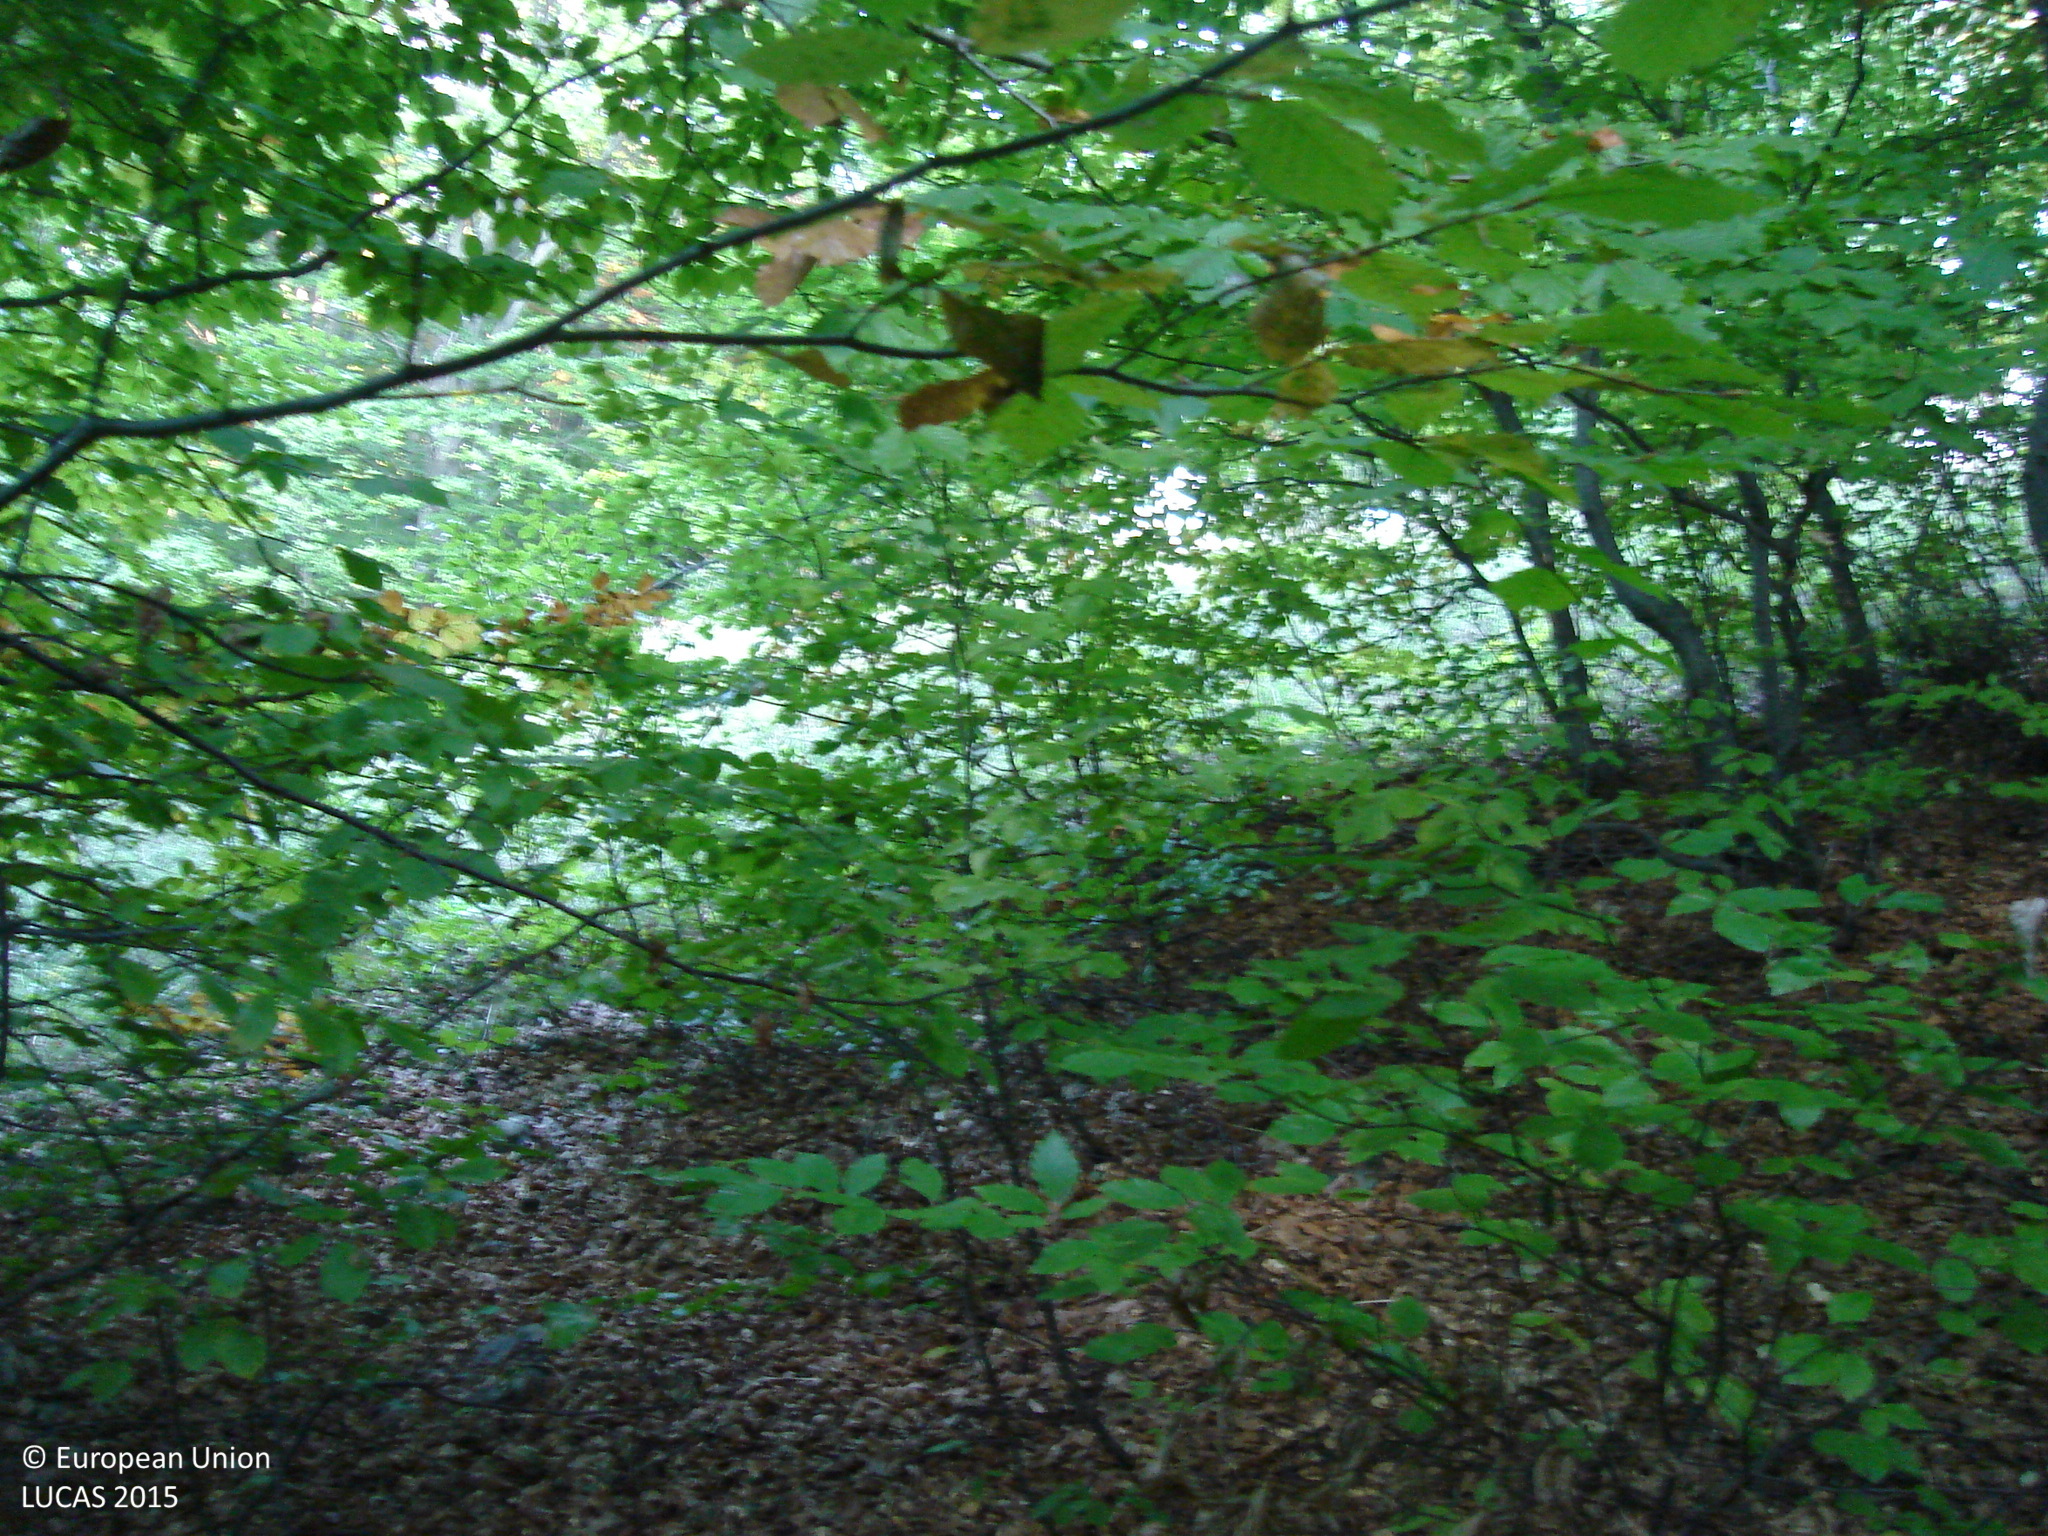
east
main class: Woodland
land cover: Broadleaved woodland
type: beech forest
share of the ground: > 75 %
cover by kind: broadleaved forest trees 85 %, consolidated bare surface 10 %, lichens and mosses 5 %
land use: Forestry
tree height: > 5 m
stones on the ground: < 10 %
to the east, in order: Broadleaved woodland; Grassland without tree/shrub cover; Broadleaved woodland; Grassland with sparse tree/shrub cover; Broadleaved woodland; Grassland with sparse tree/shrub cover; Broadleaved woodland
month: October
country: BG
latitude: 43.1442
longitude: 23.4300
